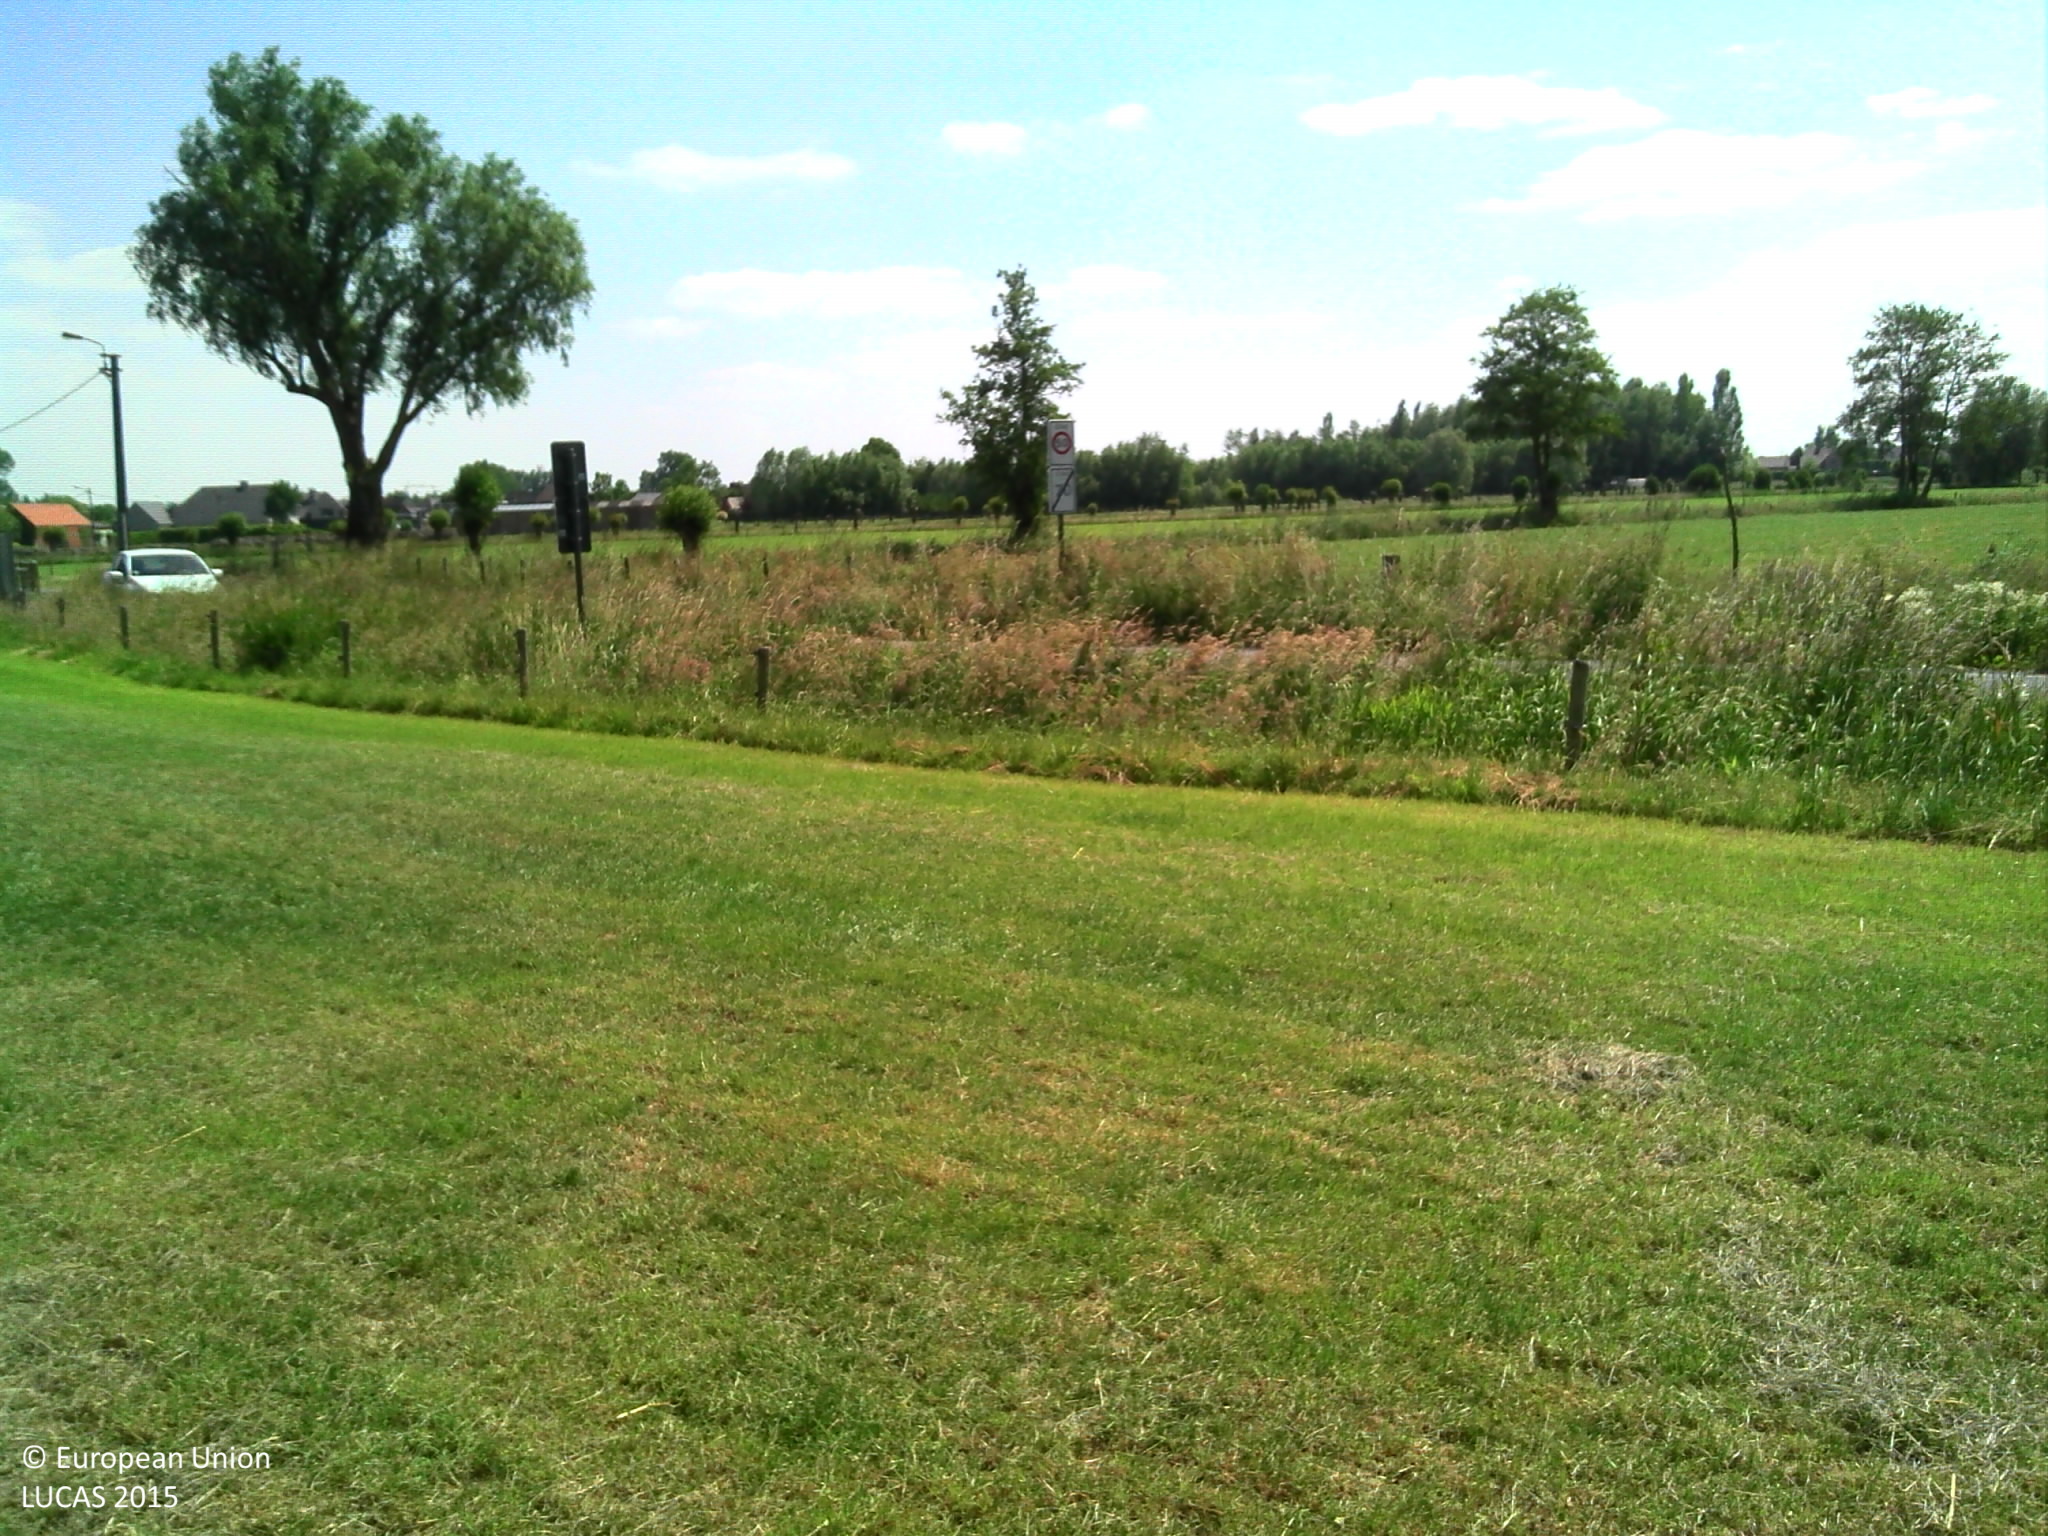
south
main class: Grassland
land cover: Grassland without tree/shrub cover
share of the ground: > 75 %
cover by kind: herbaceous plants 100 %
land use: Agriculture (excluding fallow land and kitchen gardens)
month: June
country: BE
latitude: 51.0727
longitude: 4.0142
